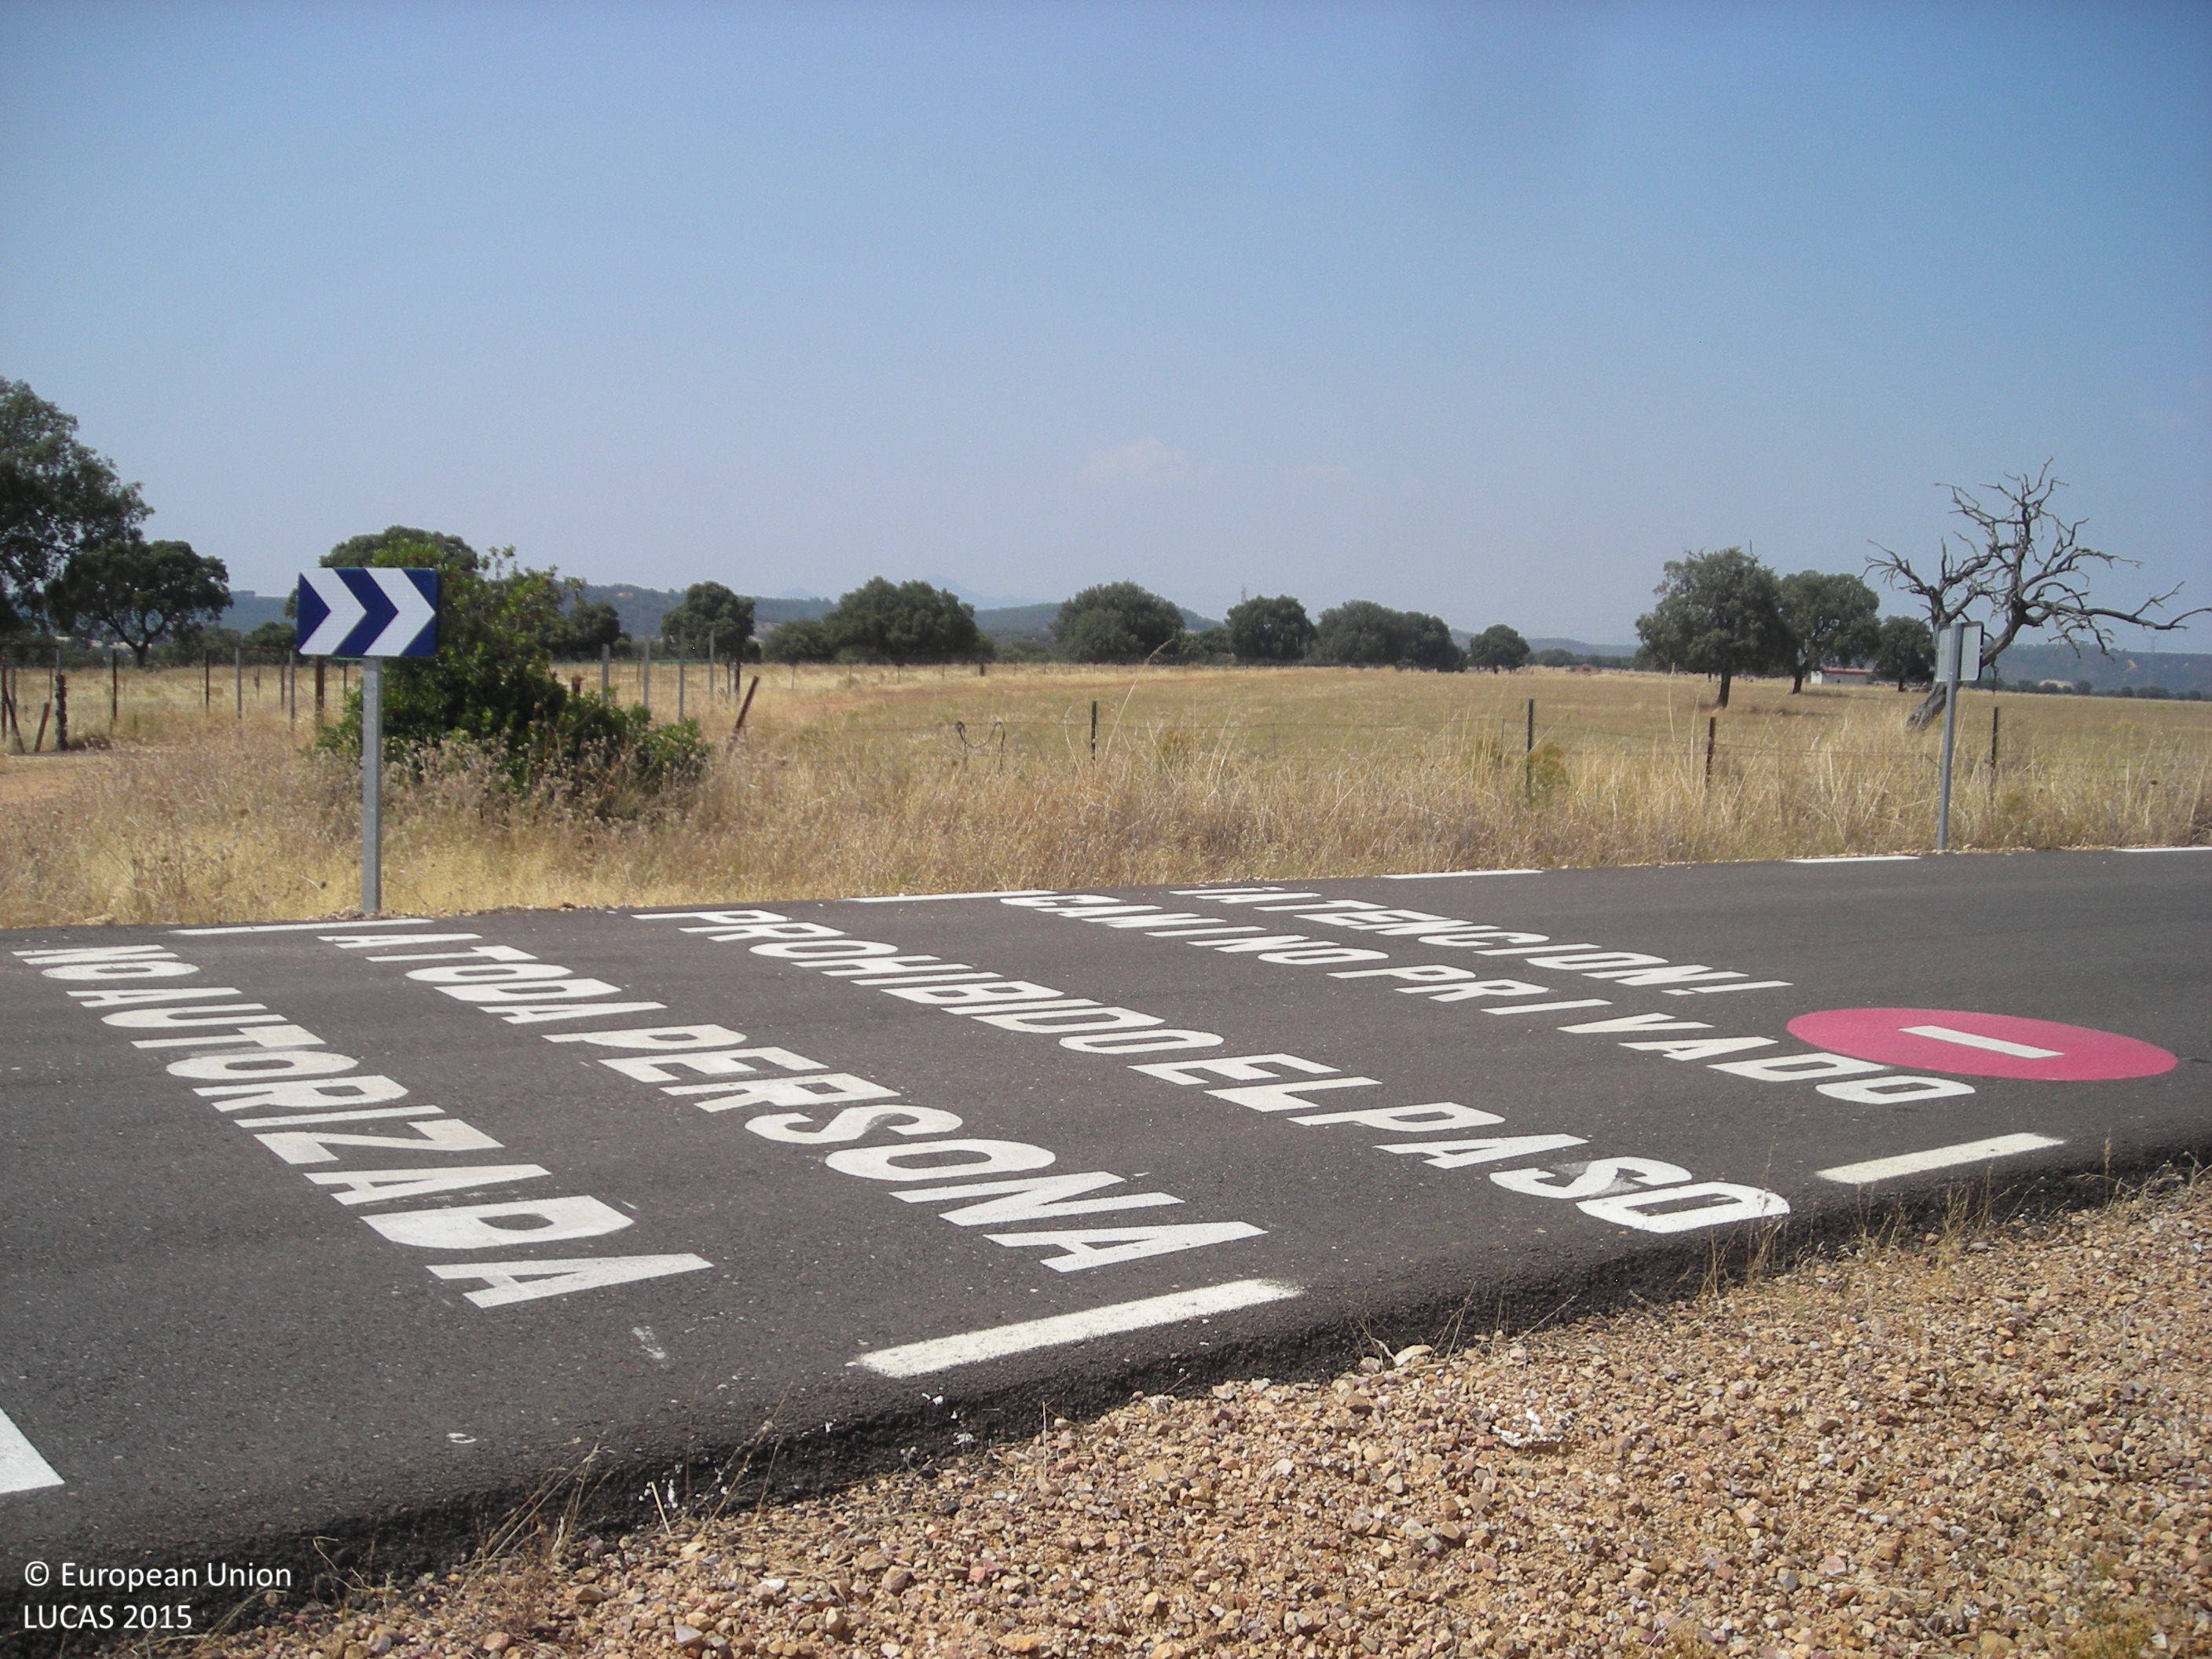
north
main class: Cropland
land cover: Olive groves
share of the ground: 25 - 50 %
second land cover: Grassland without tree/shrub cover
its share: 25 - 50 %
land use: Agriculture (excluding fallow land and kitchen gardens)
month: July
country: ES
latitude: 39.2212
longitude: -5.3221
